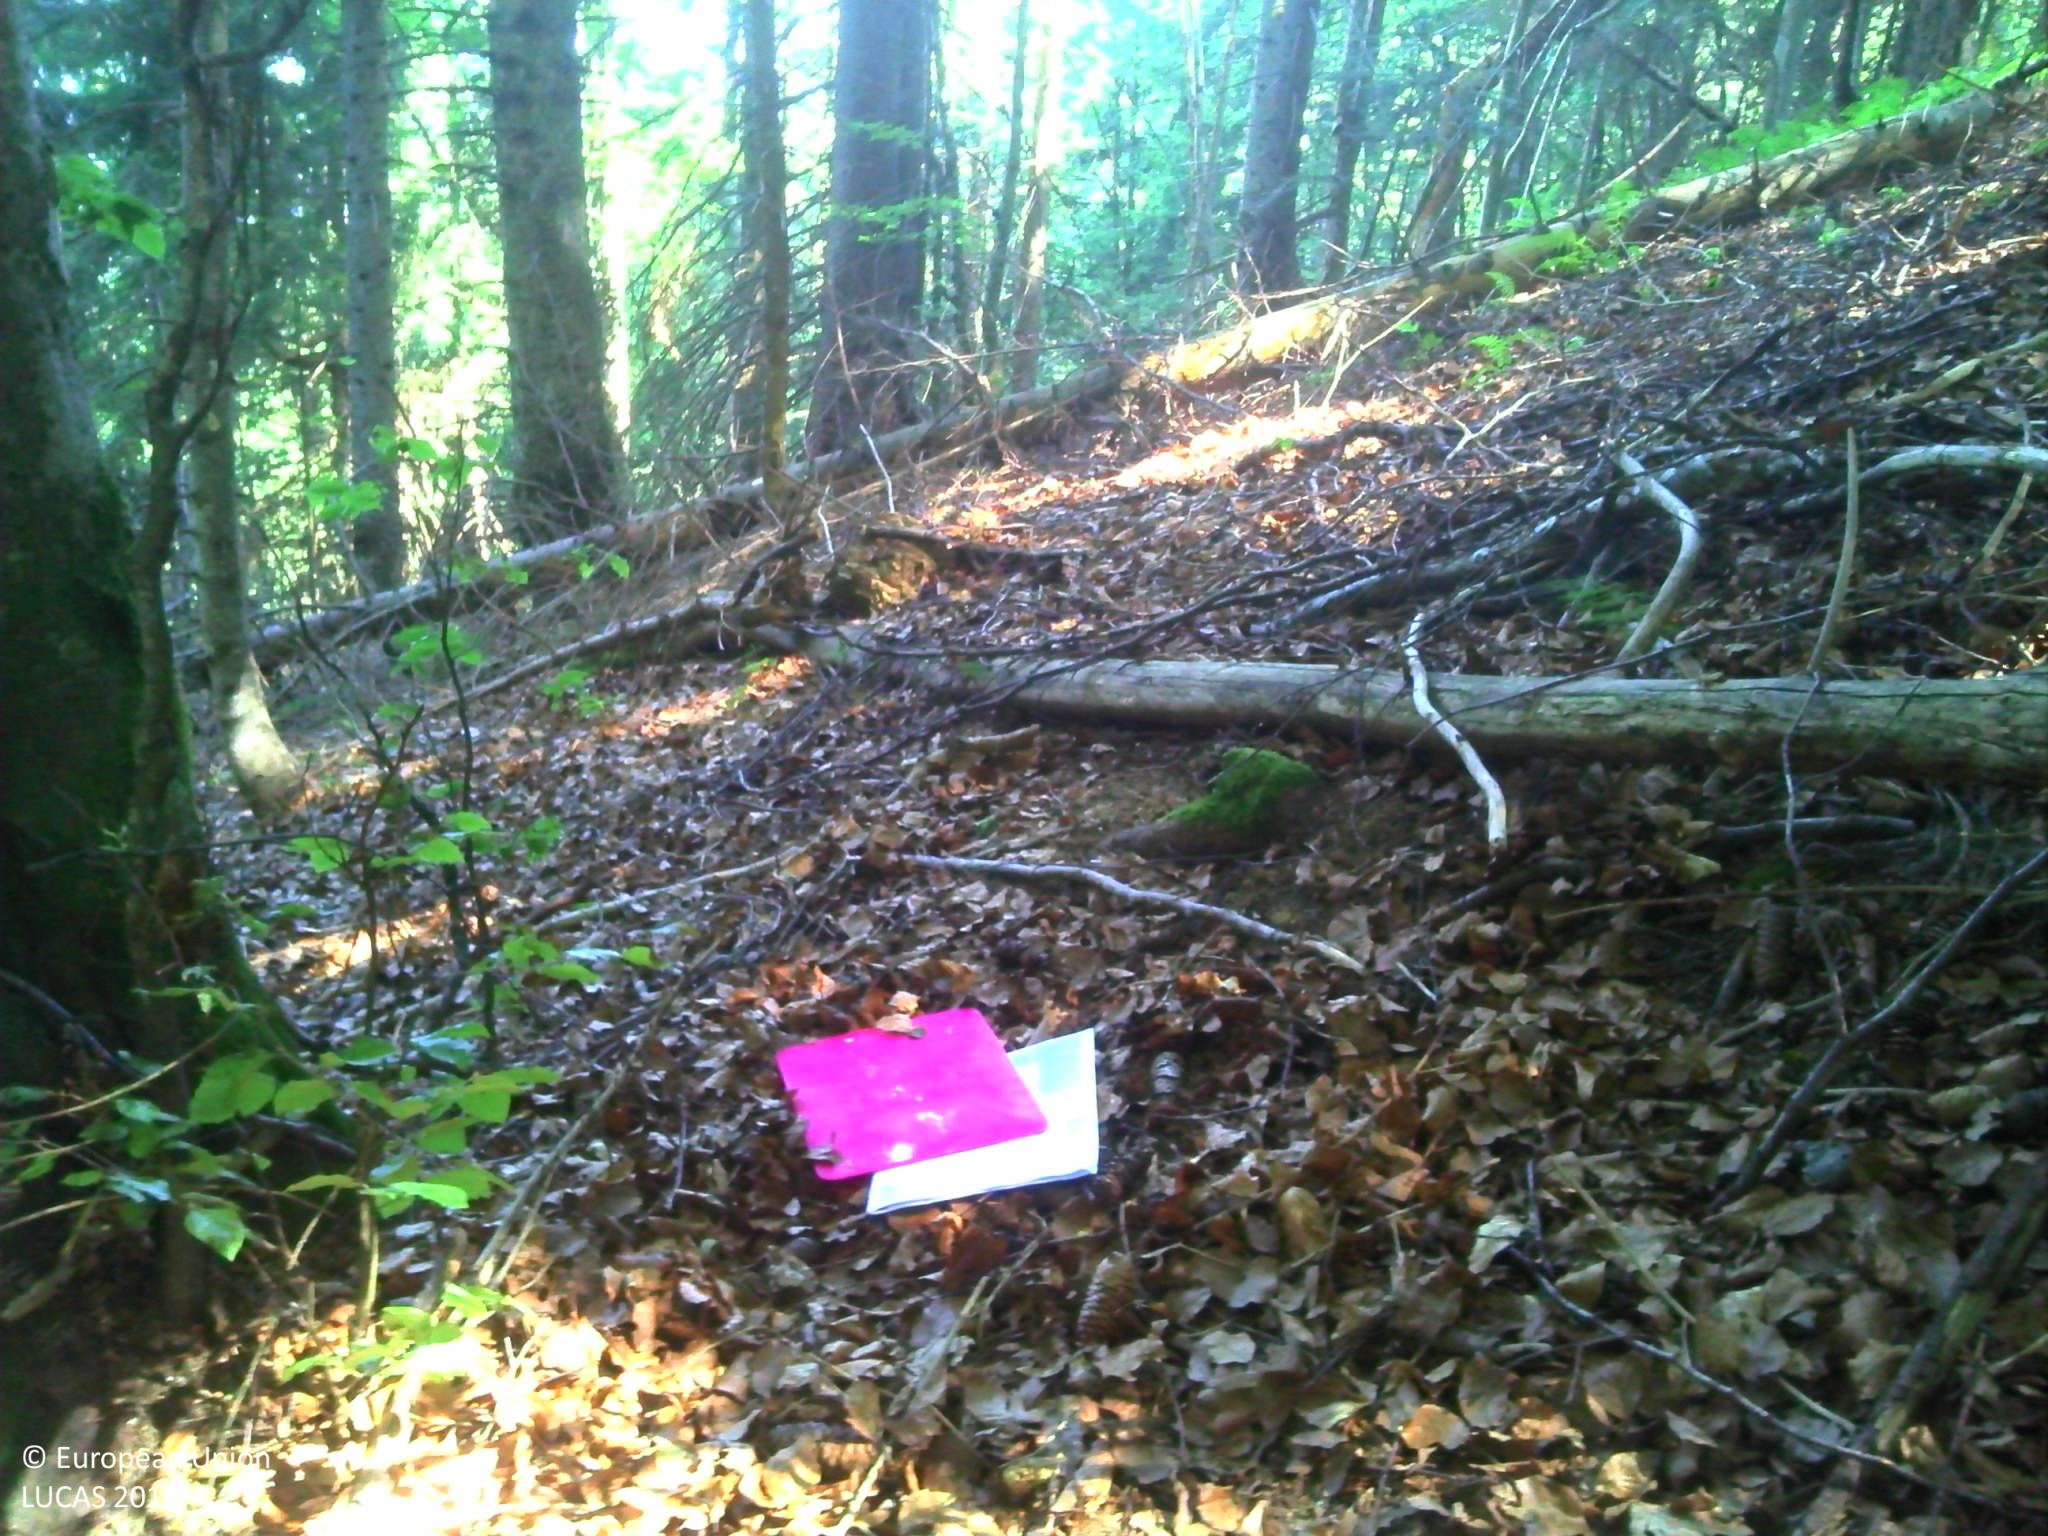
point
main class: Woodland
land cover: Spruce dominated mixed woodland
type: mountainous beech forest
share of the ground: > 75 %
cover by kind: coniferous forest trees 50 %, broadleaved forest trees 30 %, herbaceous plants 15 %, lichens and mosses 5 %
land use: Forestry
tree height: > 5 m
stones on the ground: 10 - 25 %
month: July
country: FR
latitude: 45.7593
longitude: 6.1600
